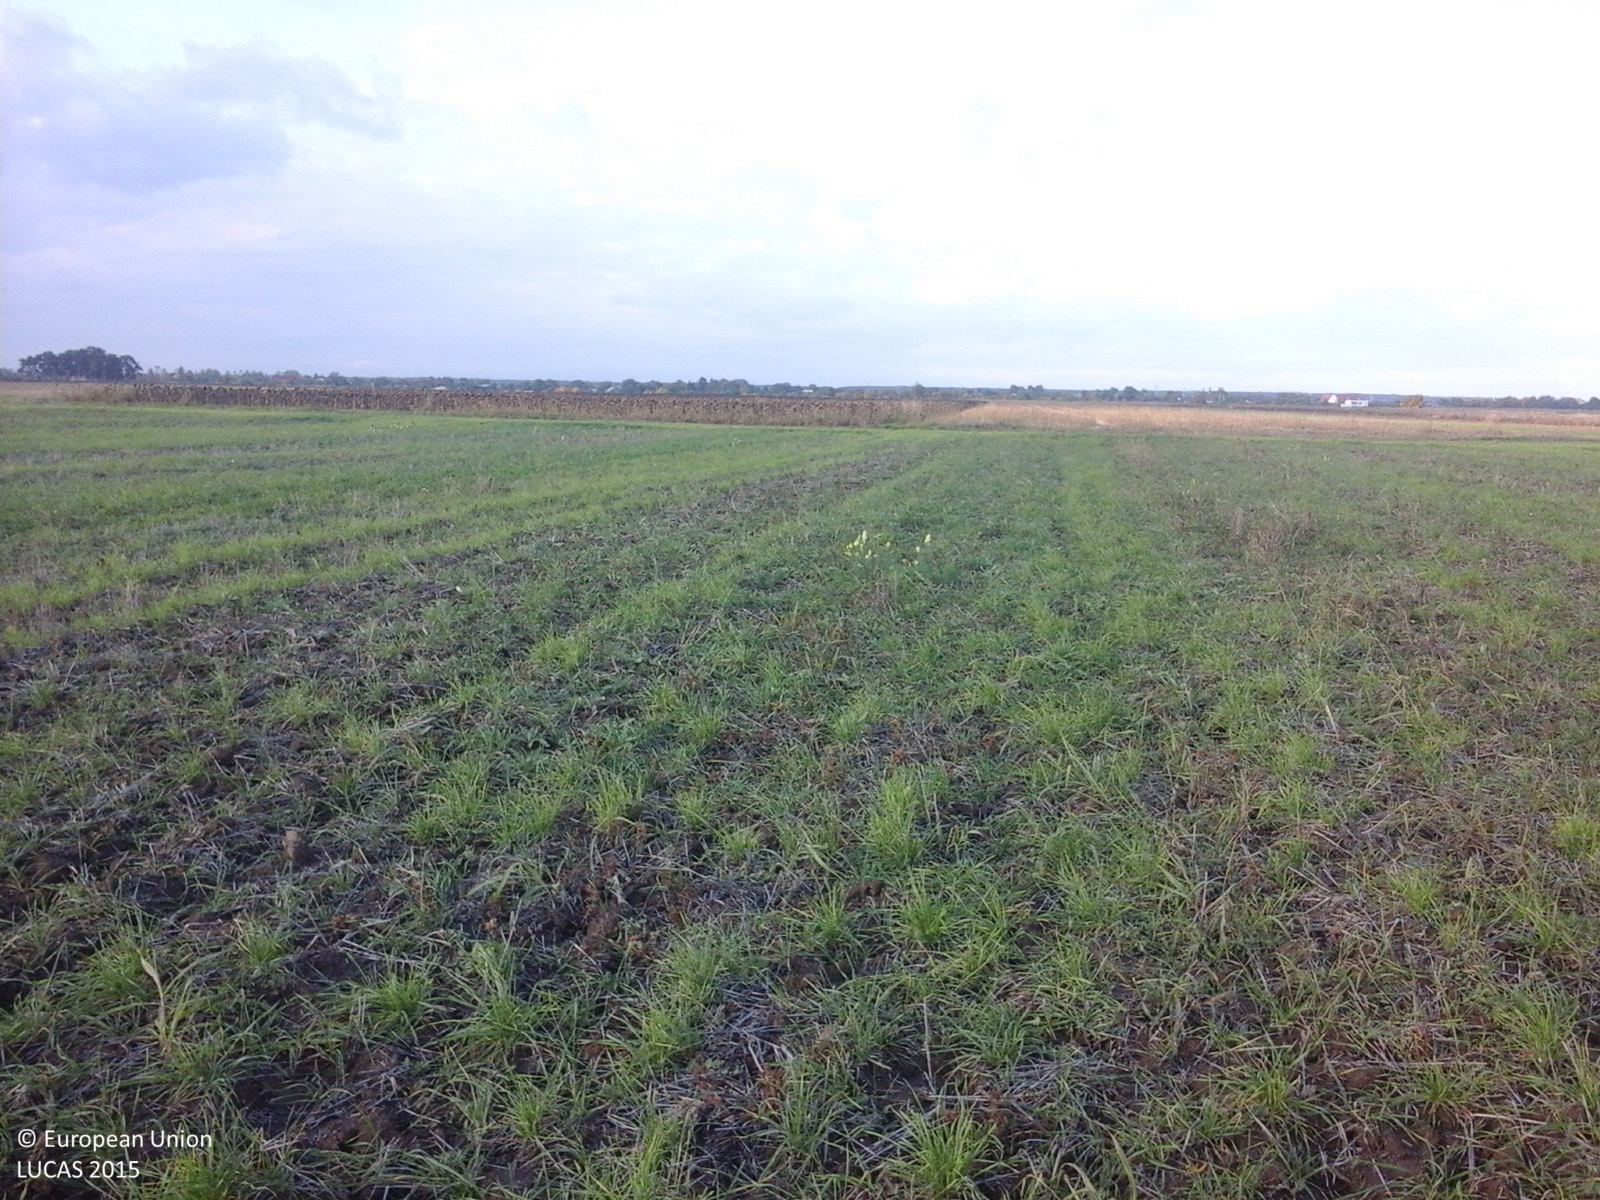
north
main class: Grassland
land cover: Grassland without tree/shrub cover
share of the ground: > 75 %
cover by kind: herbaceous plants 100 %
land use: Agriculture (excluding fallow land and kitchen gardens)
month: October
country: RO
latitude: 44.6547
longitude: 26.0325
